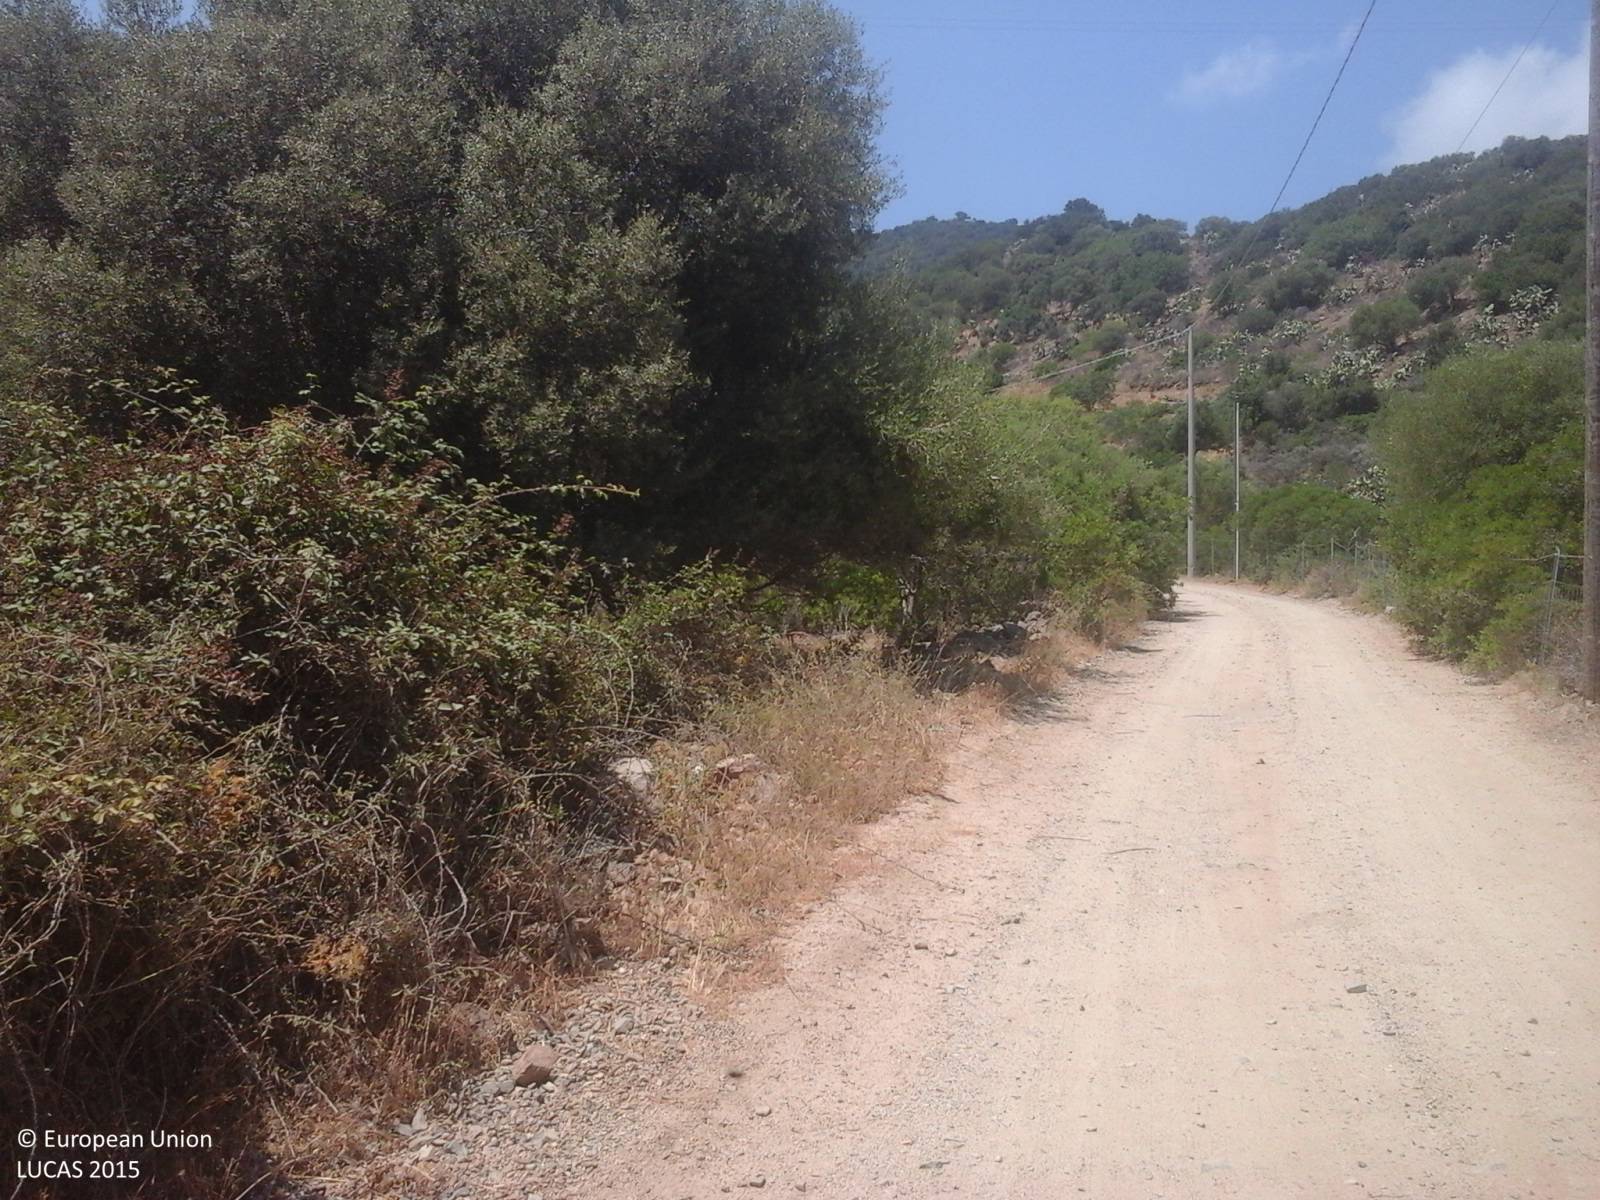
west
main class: Shrubland
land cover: Shrubland with sparse tree cover
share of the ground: > 75 %
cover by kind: herbaceous plants 60 %, shrubs 35 %, broadleaved forest trees 5 %
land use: Semi-natural and natural areas not in use
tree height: > 5 m
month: July
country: IT
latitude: 39.3972
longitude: 9.5960
